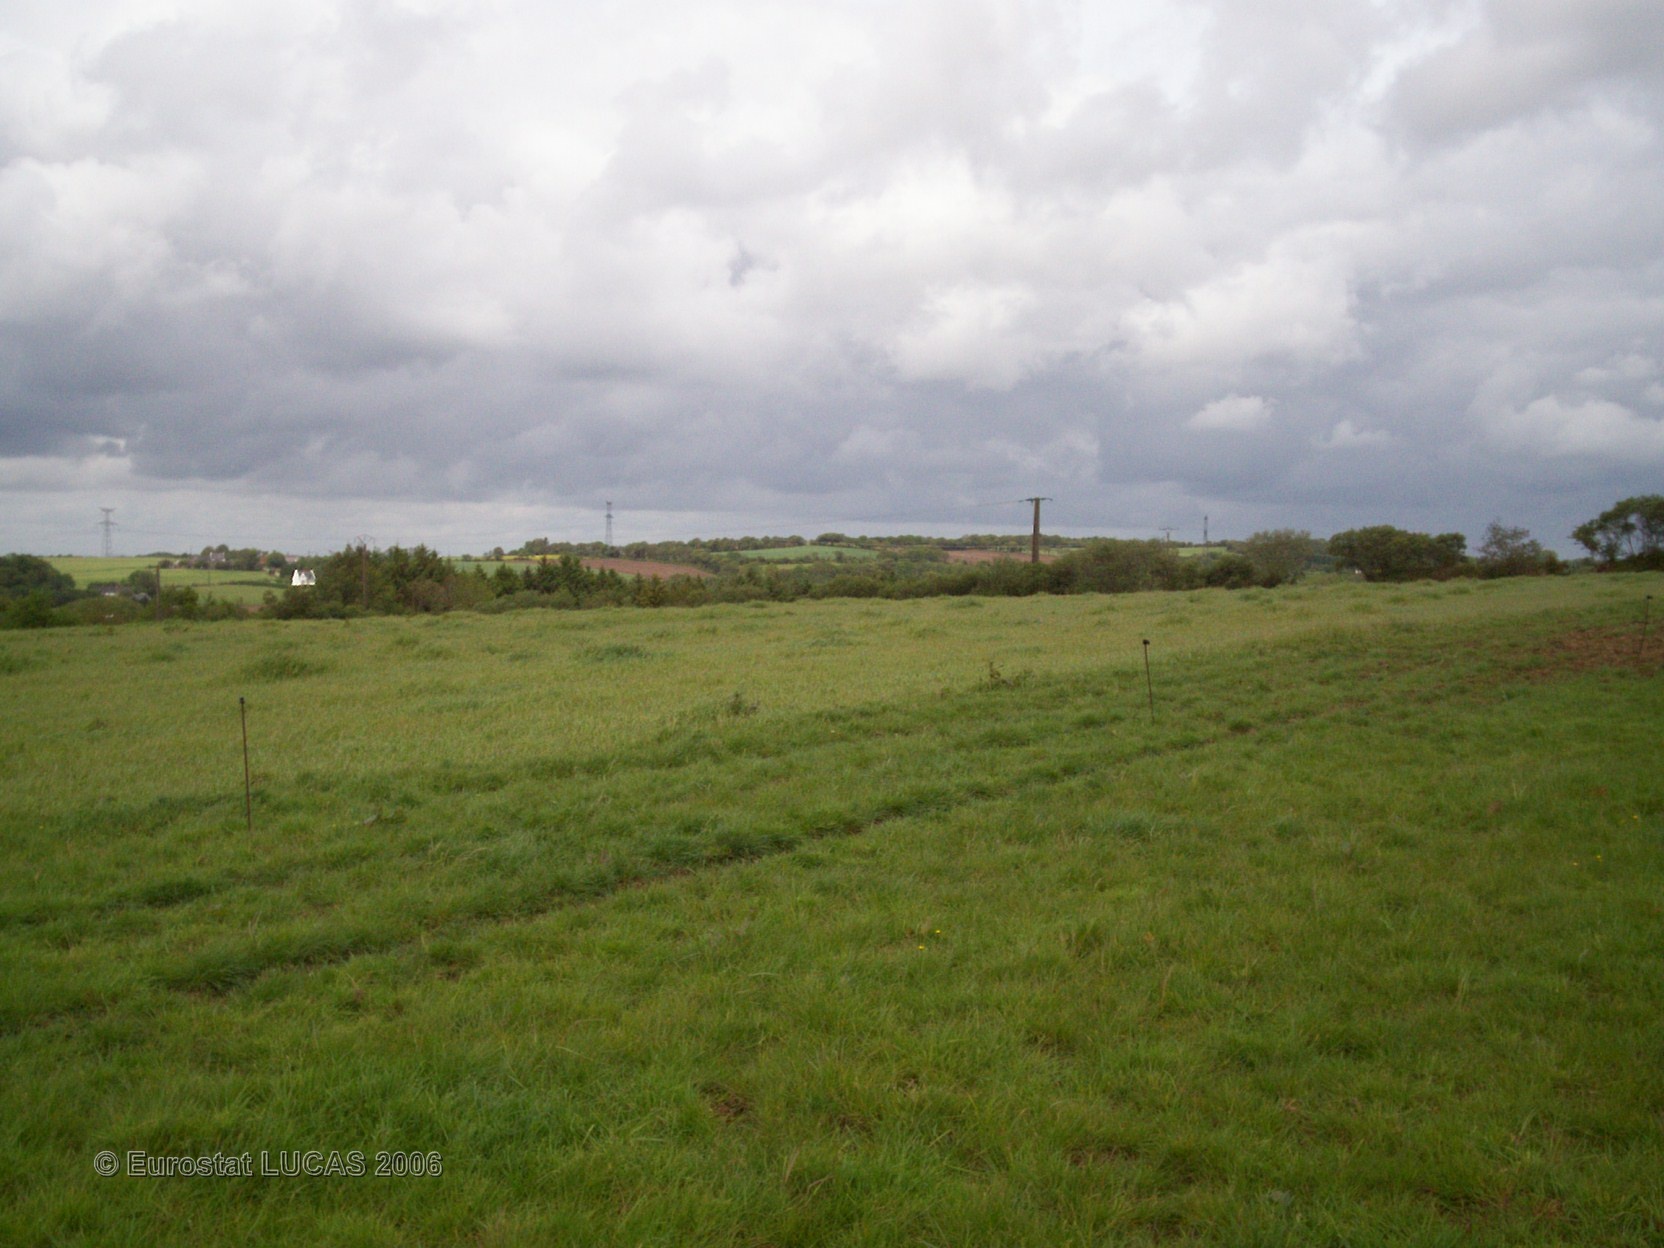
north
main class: Grassland
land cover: Grassland without tree/shrub cover
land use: Agriculture (excluding fallow land and kitchen gardens)
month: May
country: FR
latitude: 48.1181
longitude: -3.9352
